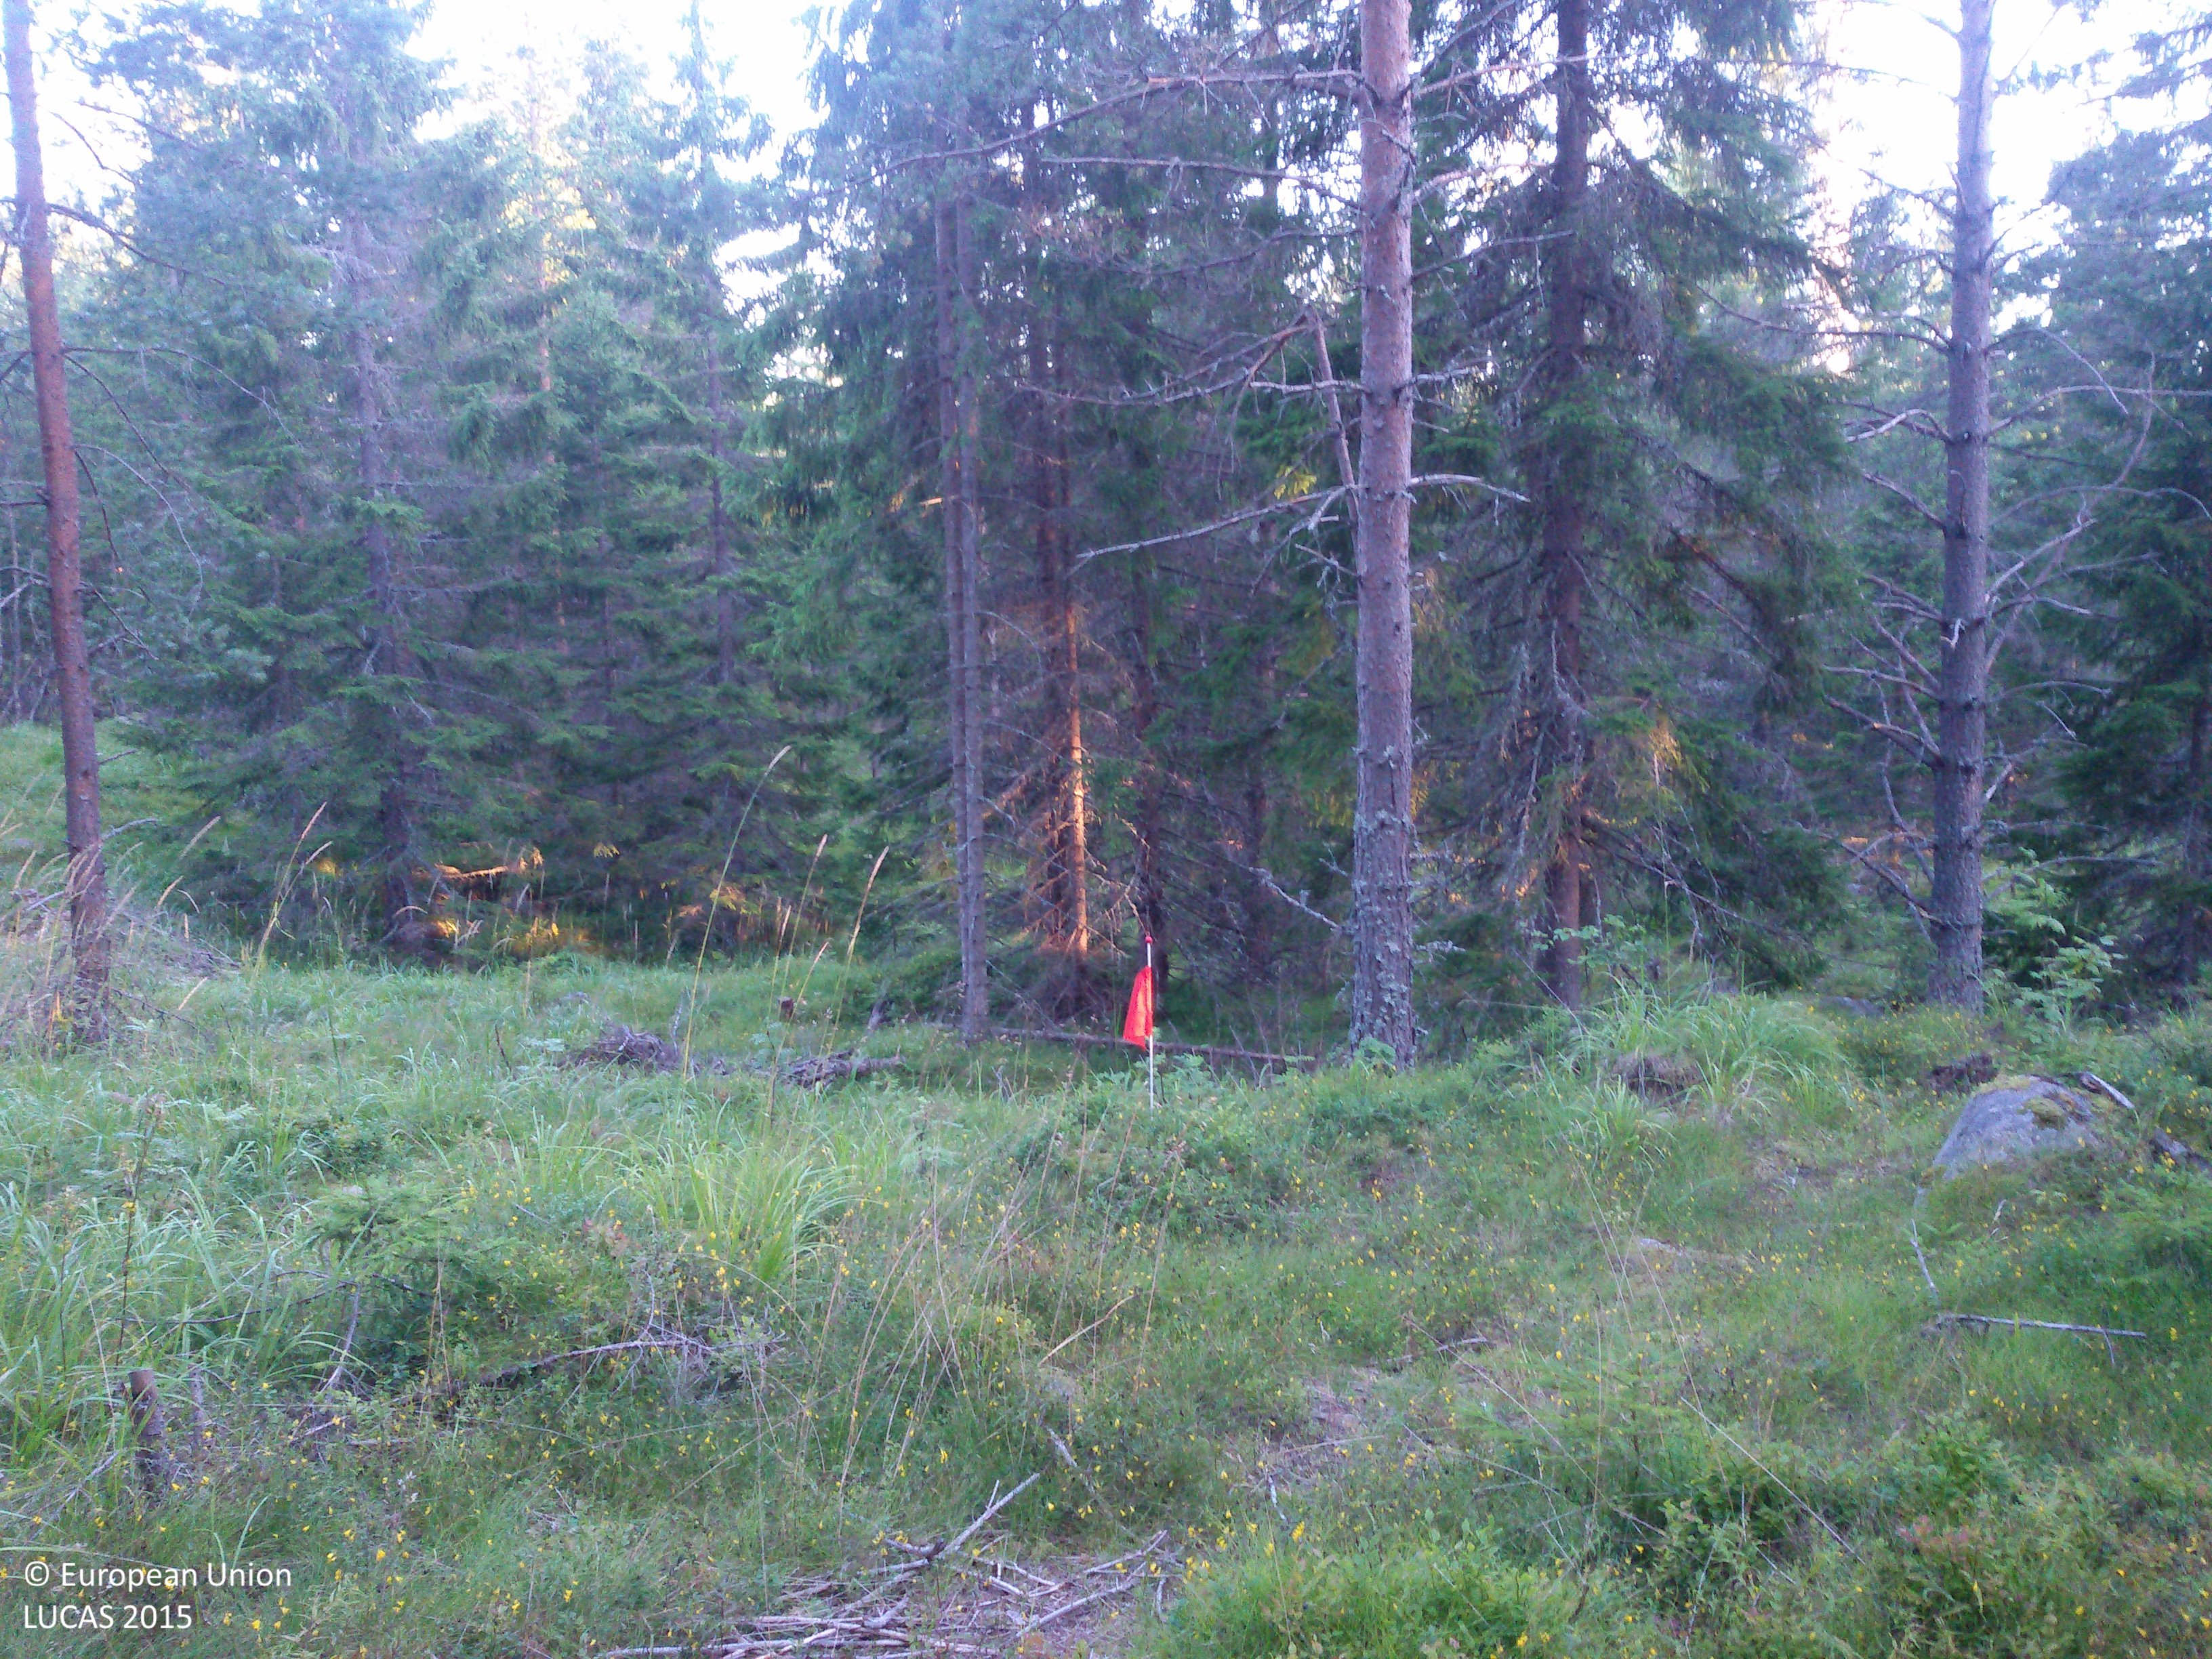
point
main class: Woodland
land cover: Other coniferous woodland
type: boreal forest
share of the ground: 50 - 75 %
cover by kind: coniferous forest trees 60 %, herbaceous plants 25 %, lichens and mosses 15 %
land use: Forestry
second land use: Other primary production
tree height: > 5 m
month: August
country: SE
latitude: 60.7862
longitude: 16.5814
